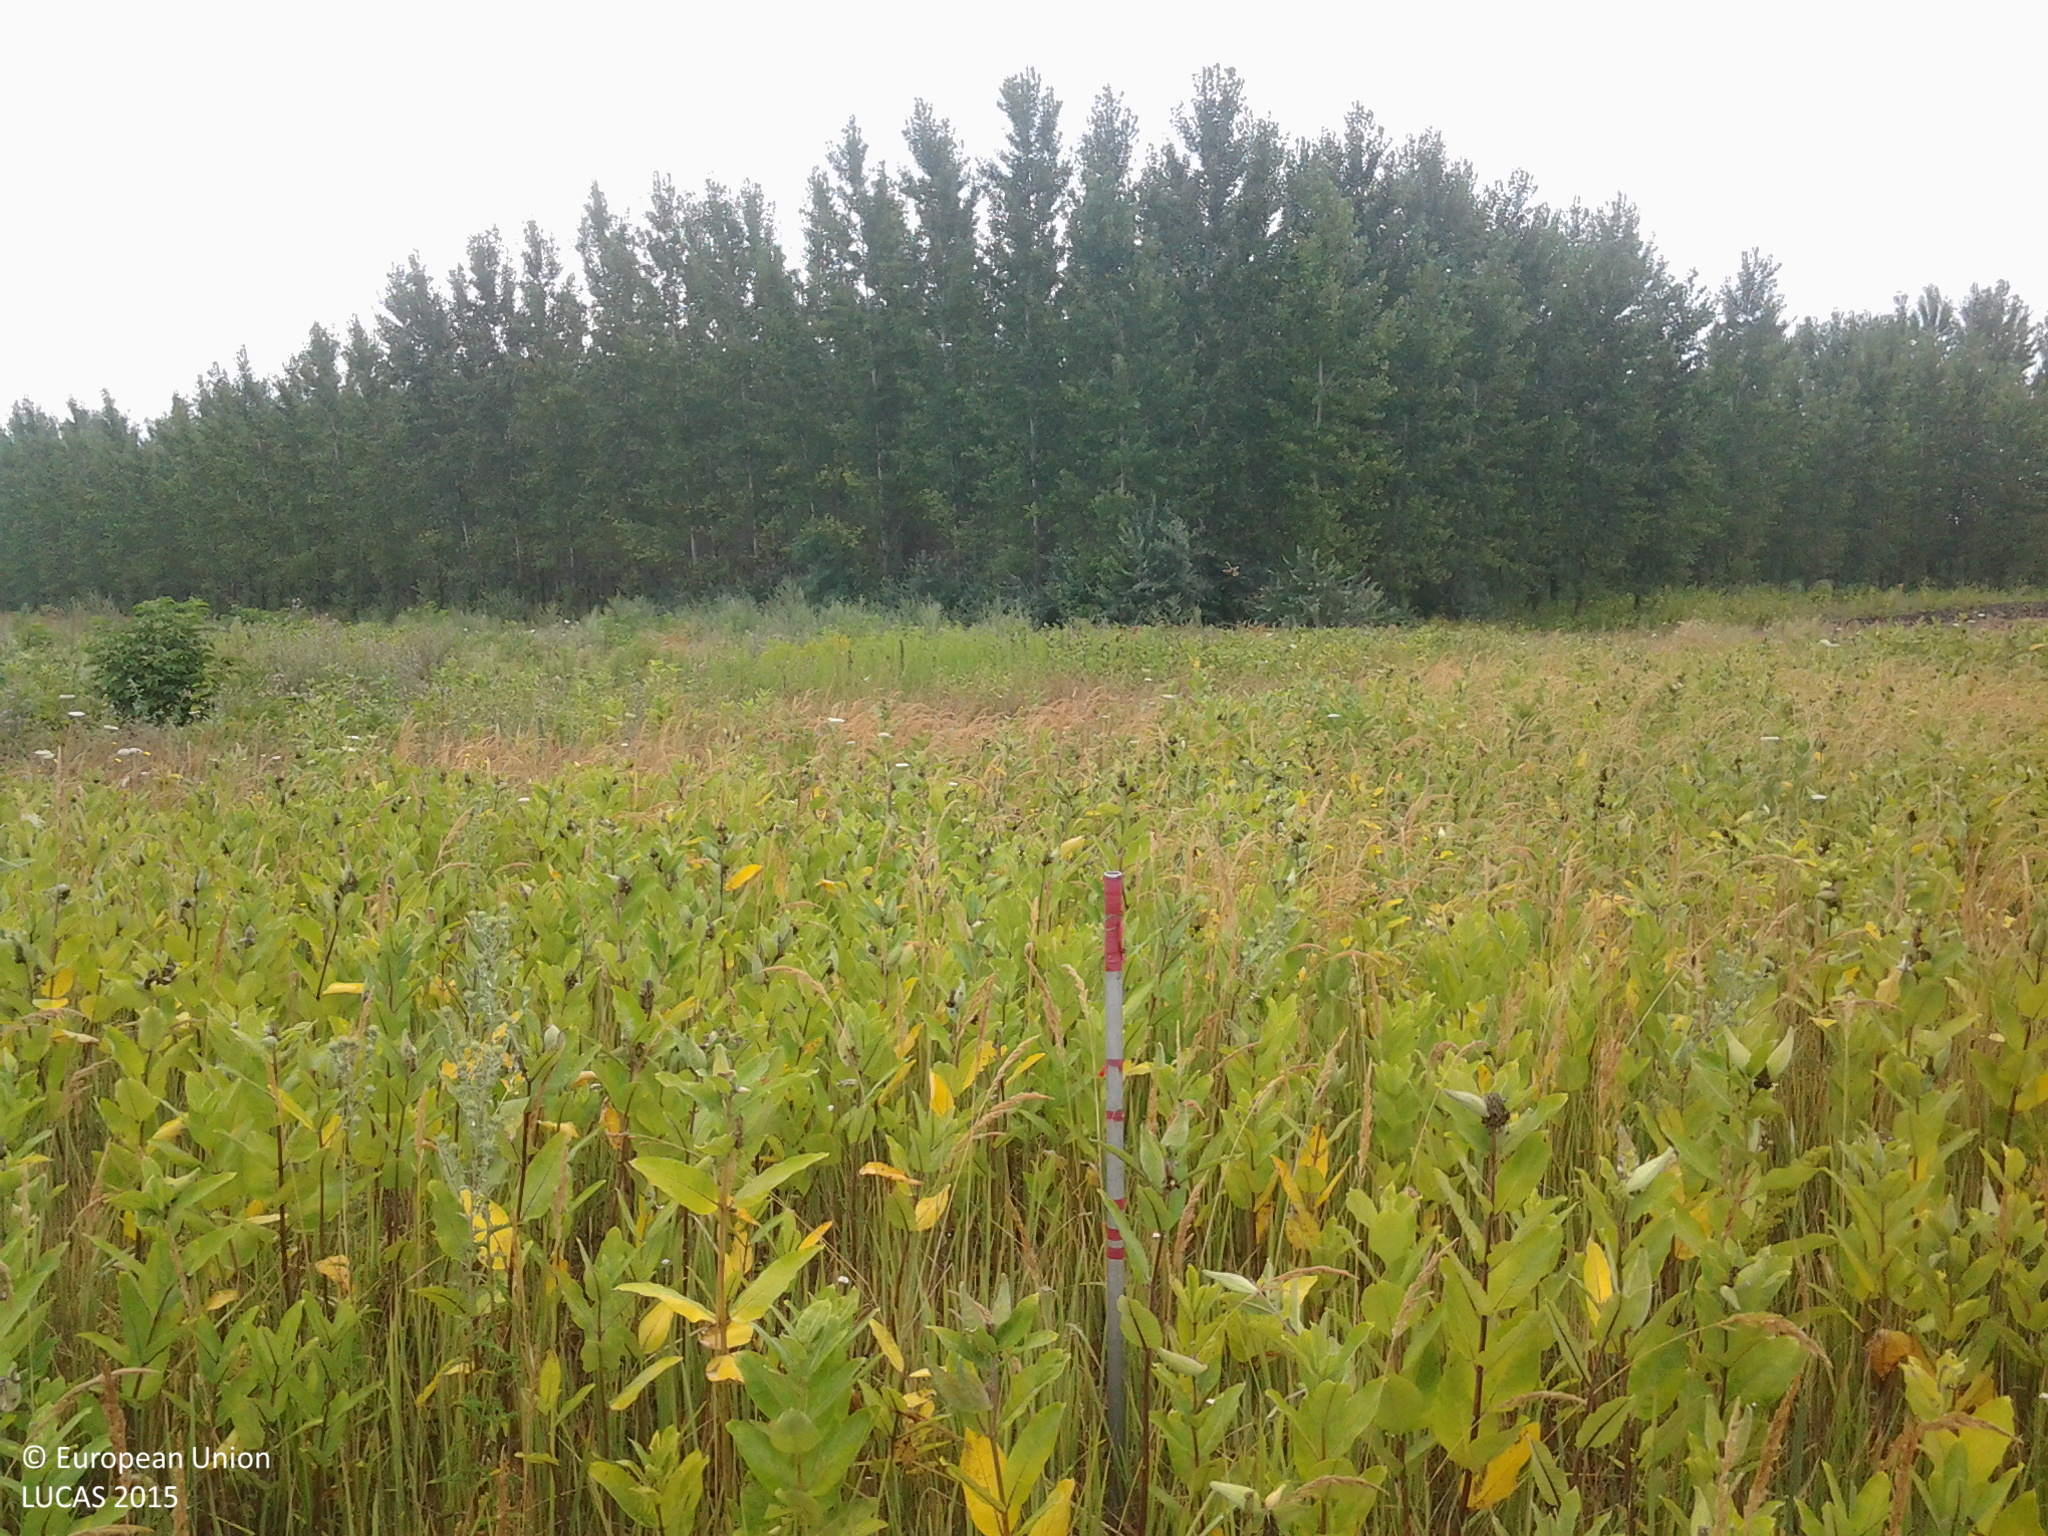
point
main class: Grassland
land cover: Spontaneously vegetated surfaces
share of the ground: > 75 %
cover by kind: herbaceous plants 100 %
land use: Semi-natural and natural areas not in use
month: July
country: HU
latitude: 46.9282
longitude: 19.2501
